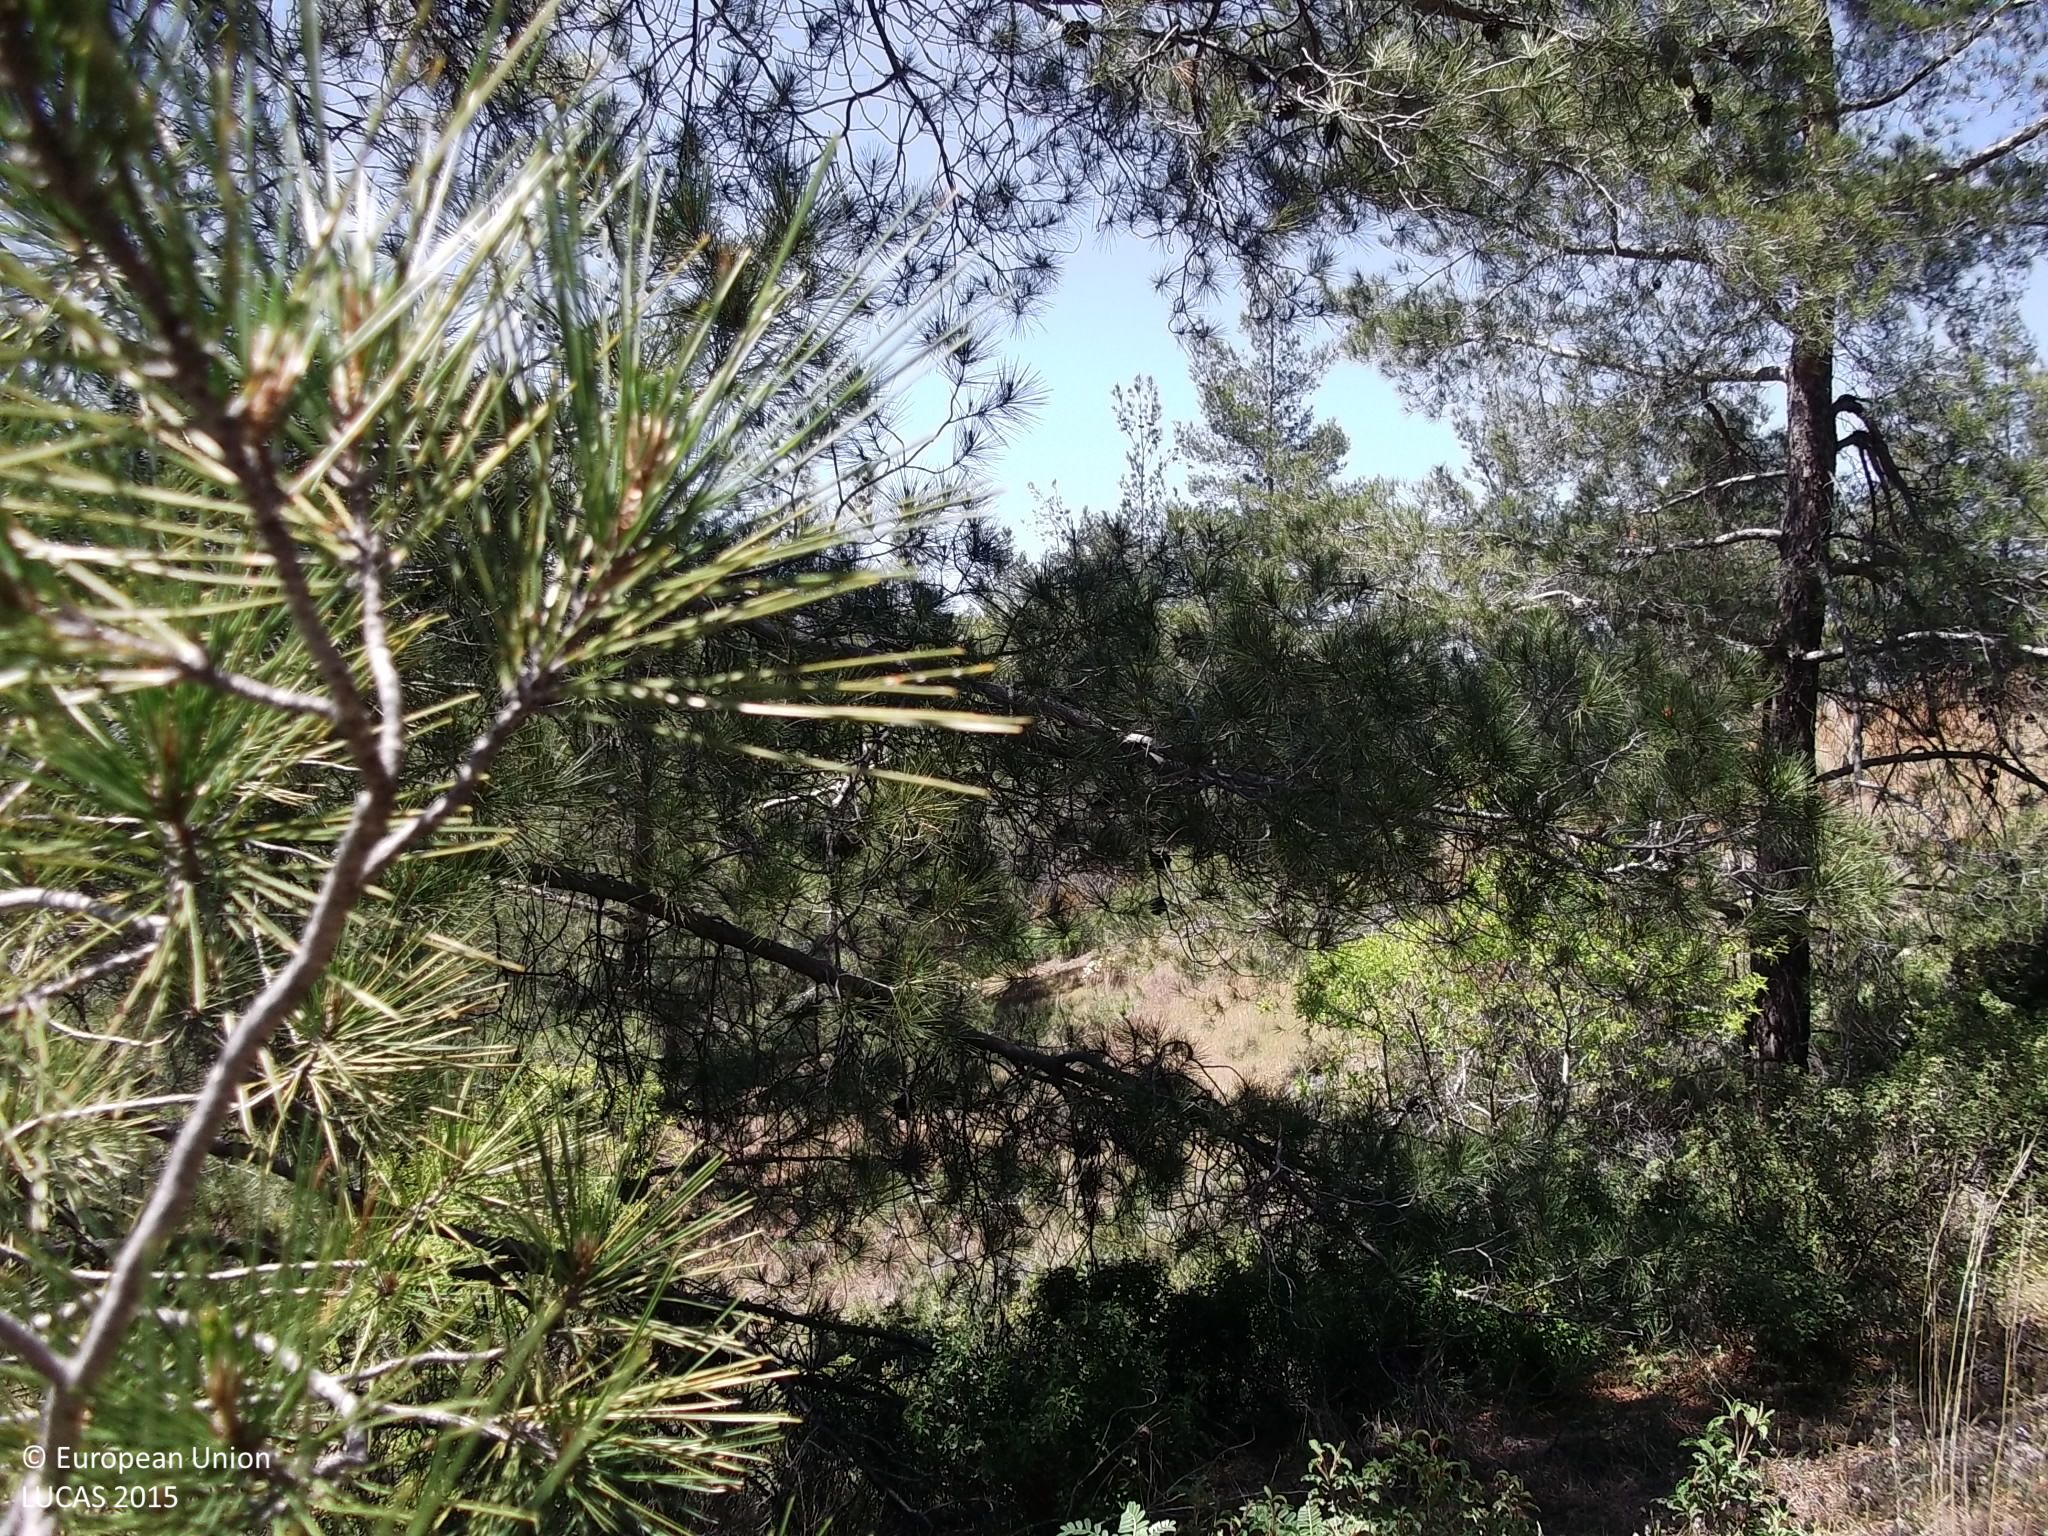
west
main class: Woodland
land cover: Pine dominated coniferous woodland
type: coniferous forest of the mediterranean region
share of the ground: 50 - 75 %
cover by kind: coniferous forest trees 70 %, shrubs 20 %, unconsolidated bare surface 10 %
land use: Semi-natural and natural areas not in use
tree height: > 5 m
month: April
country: CY
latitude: 34.9406
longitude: 33.1598
